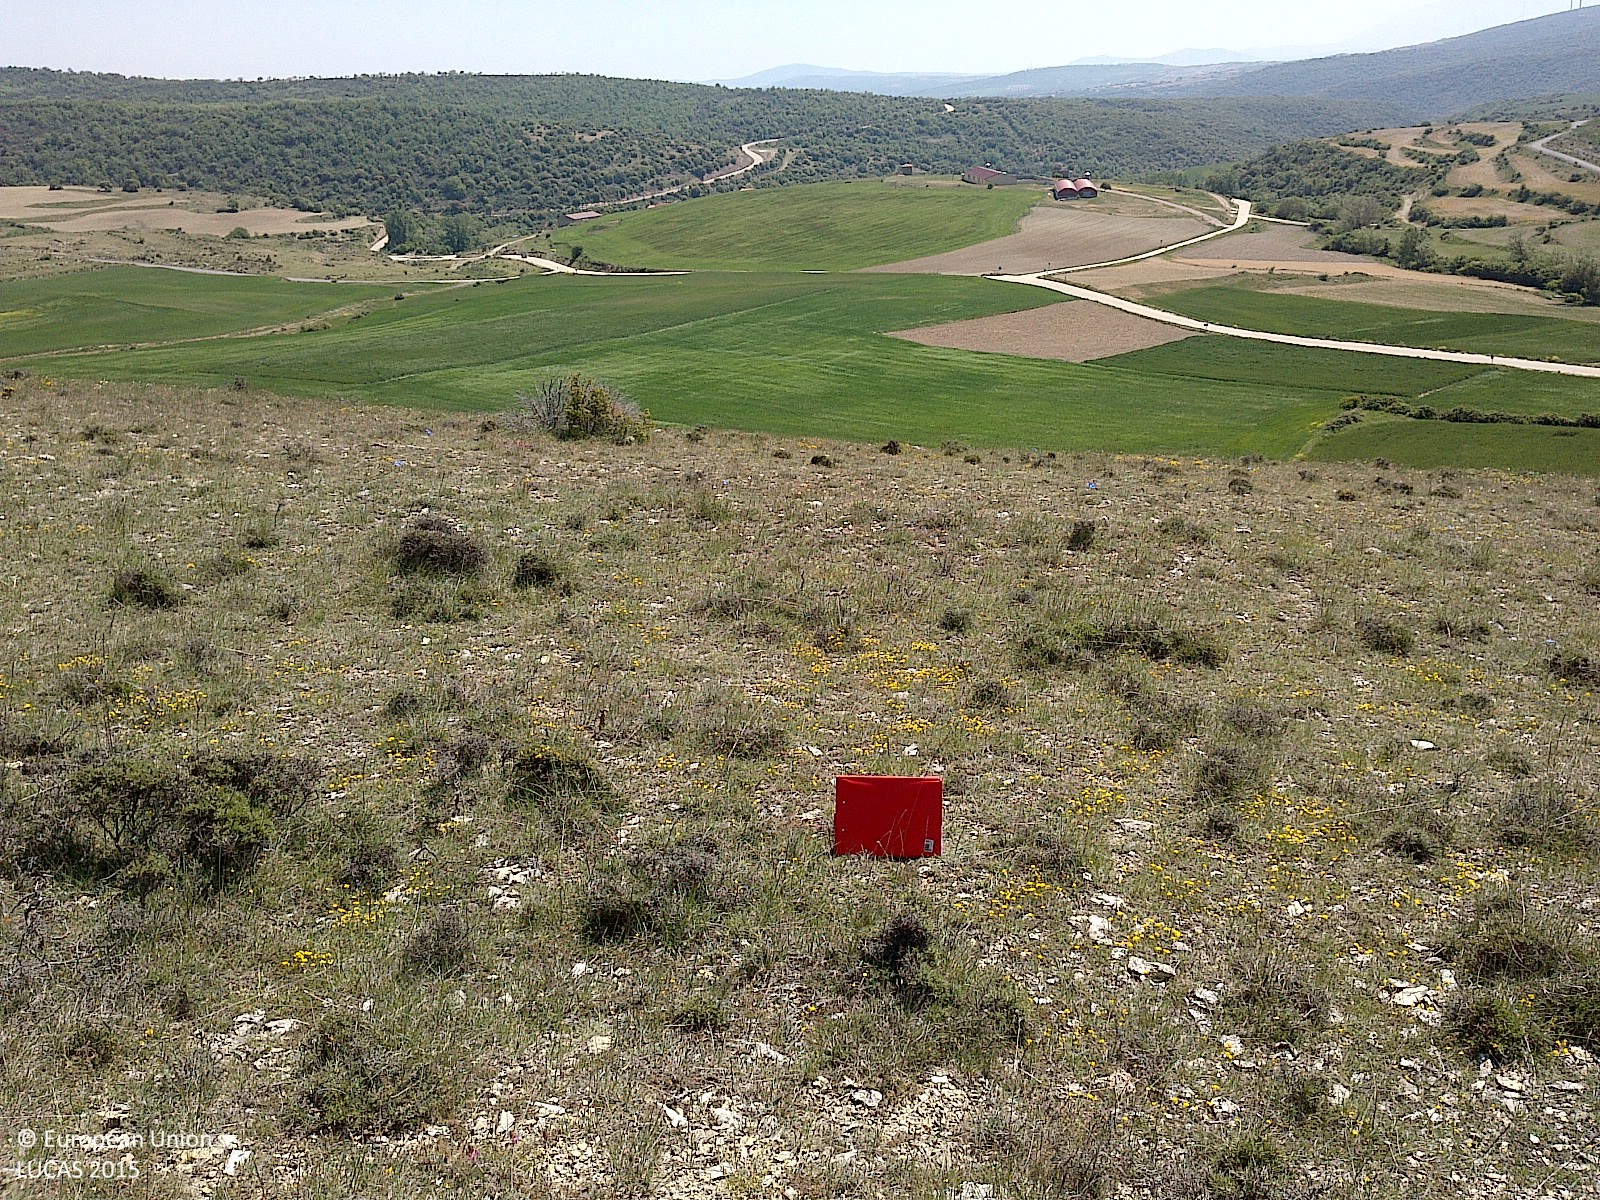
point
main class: Grassland
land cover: Grassland without tree/shrub cover
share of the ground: > 75 %
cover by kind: herbaceous plants 85 %, consolidated bare surface 10 %, shrubs 5 %
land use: Semi-natural and natural areas not in use
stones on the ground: < 10 %
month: May
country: ES
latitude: 41.8897
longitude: -2.2454
